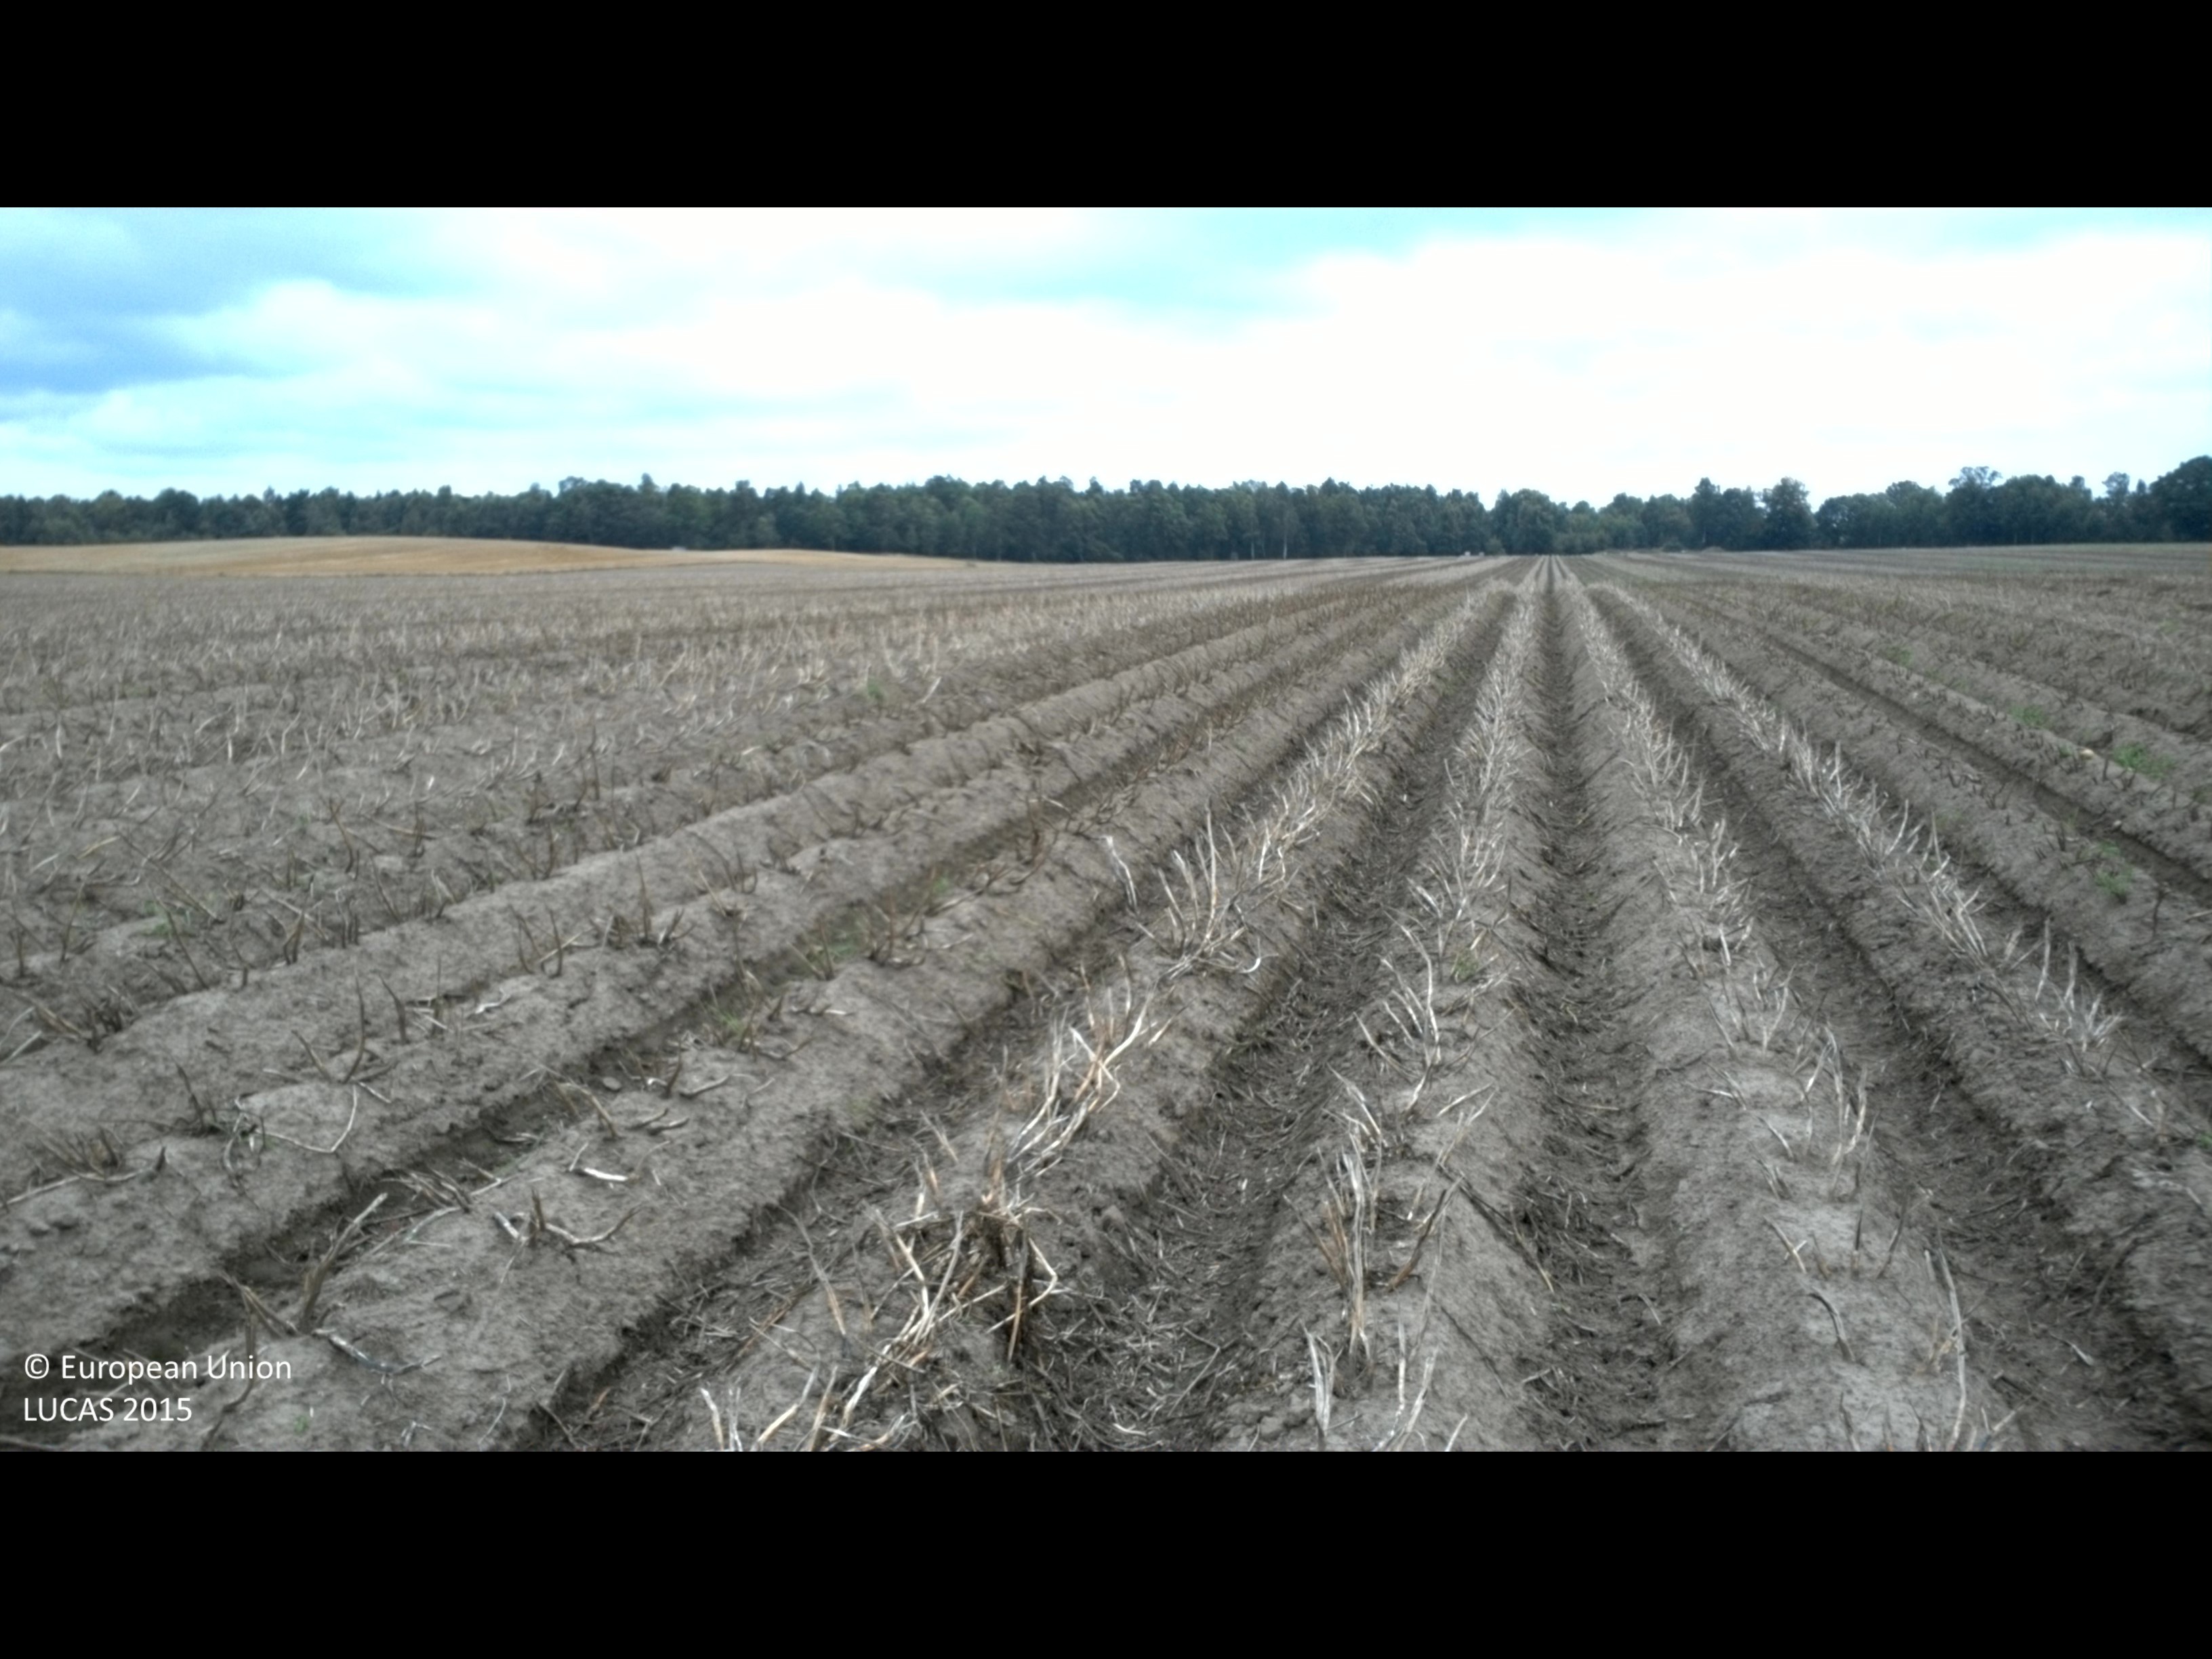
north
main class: Cropland
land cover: Potatoes
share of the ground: < 10 %
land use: Agriculture (excluding fallow land and kitchen gardens)
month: September
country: SE
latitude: 56.1762
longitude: 14.1053
